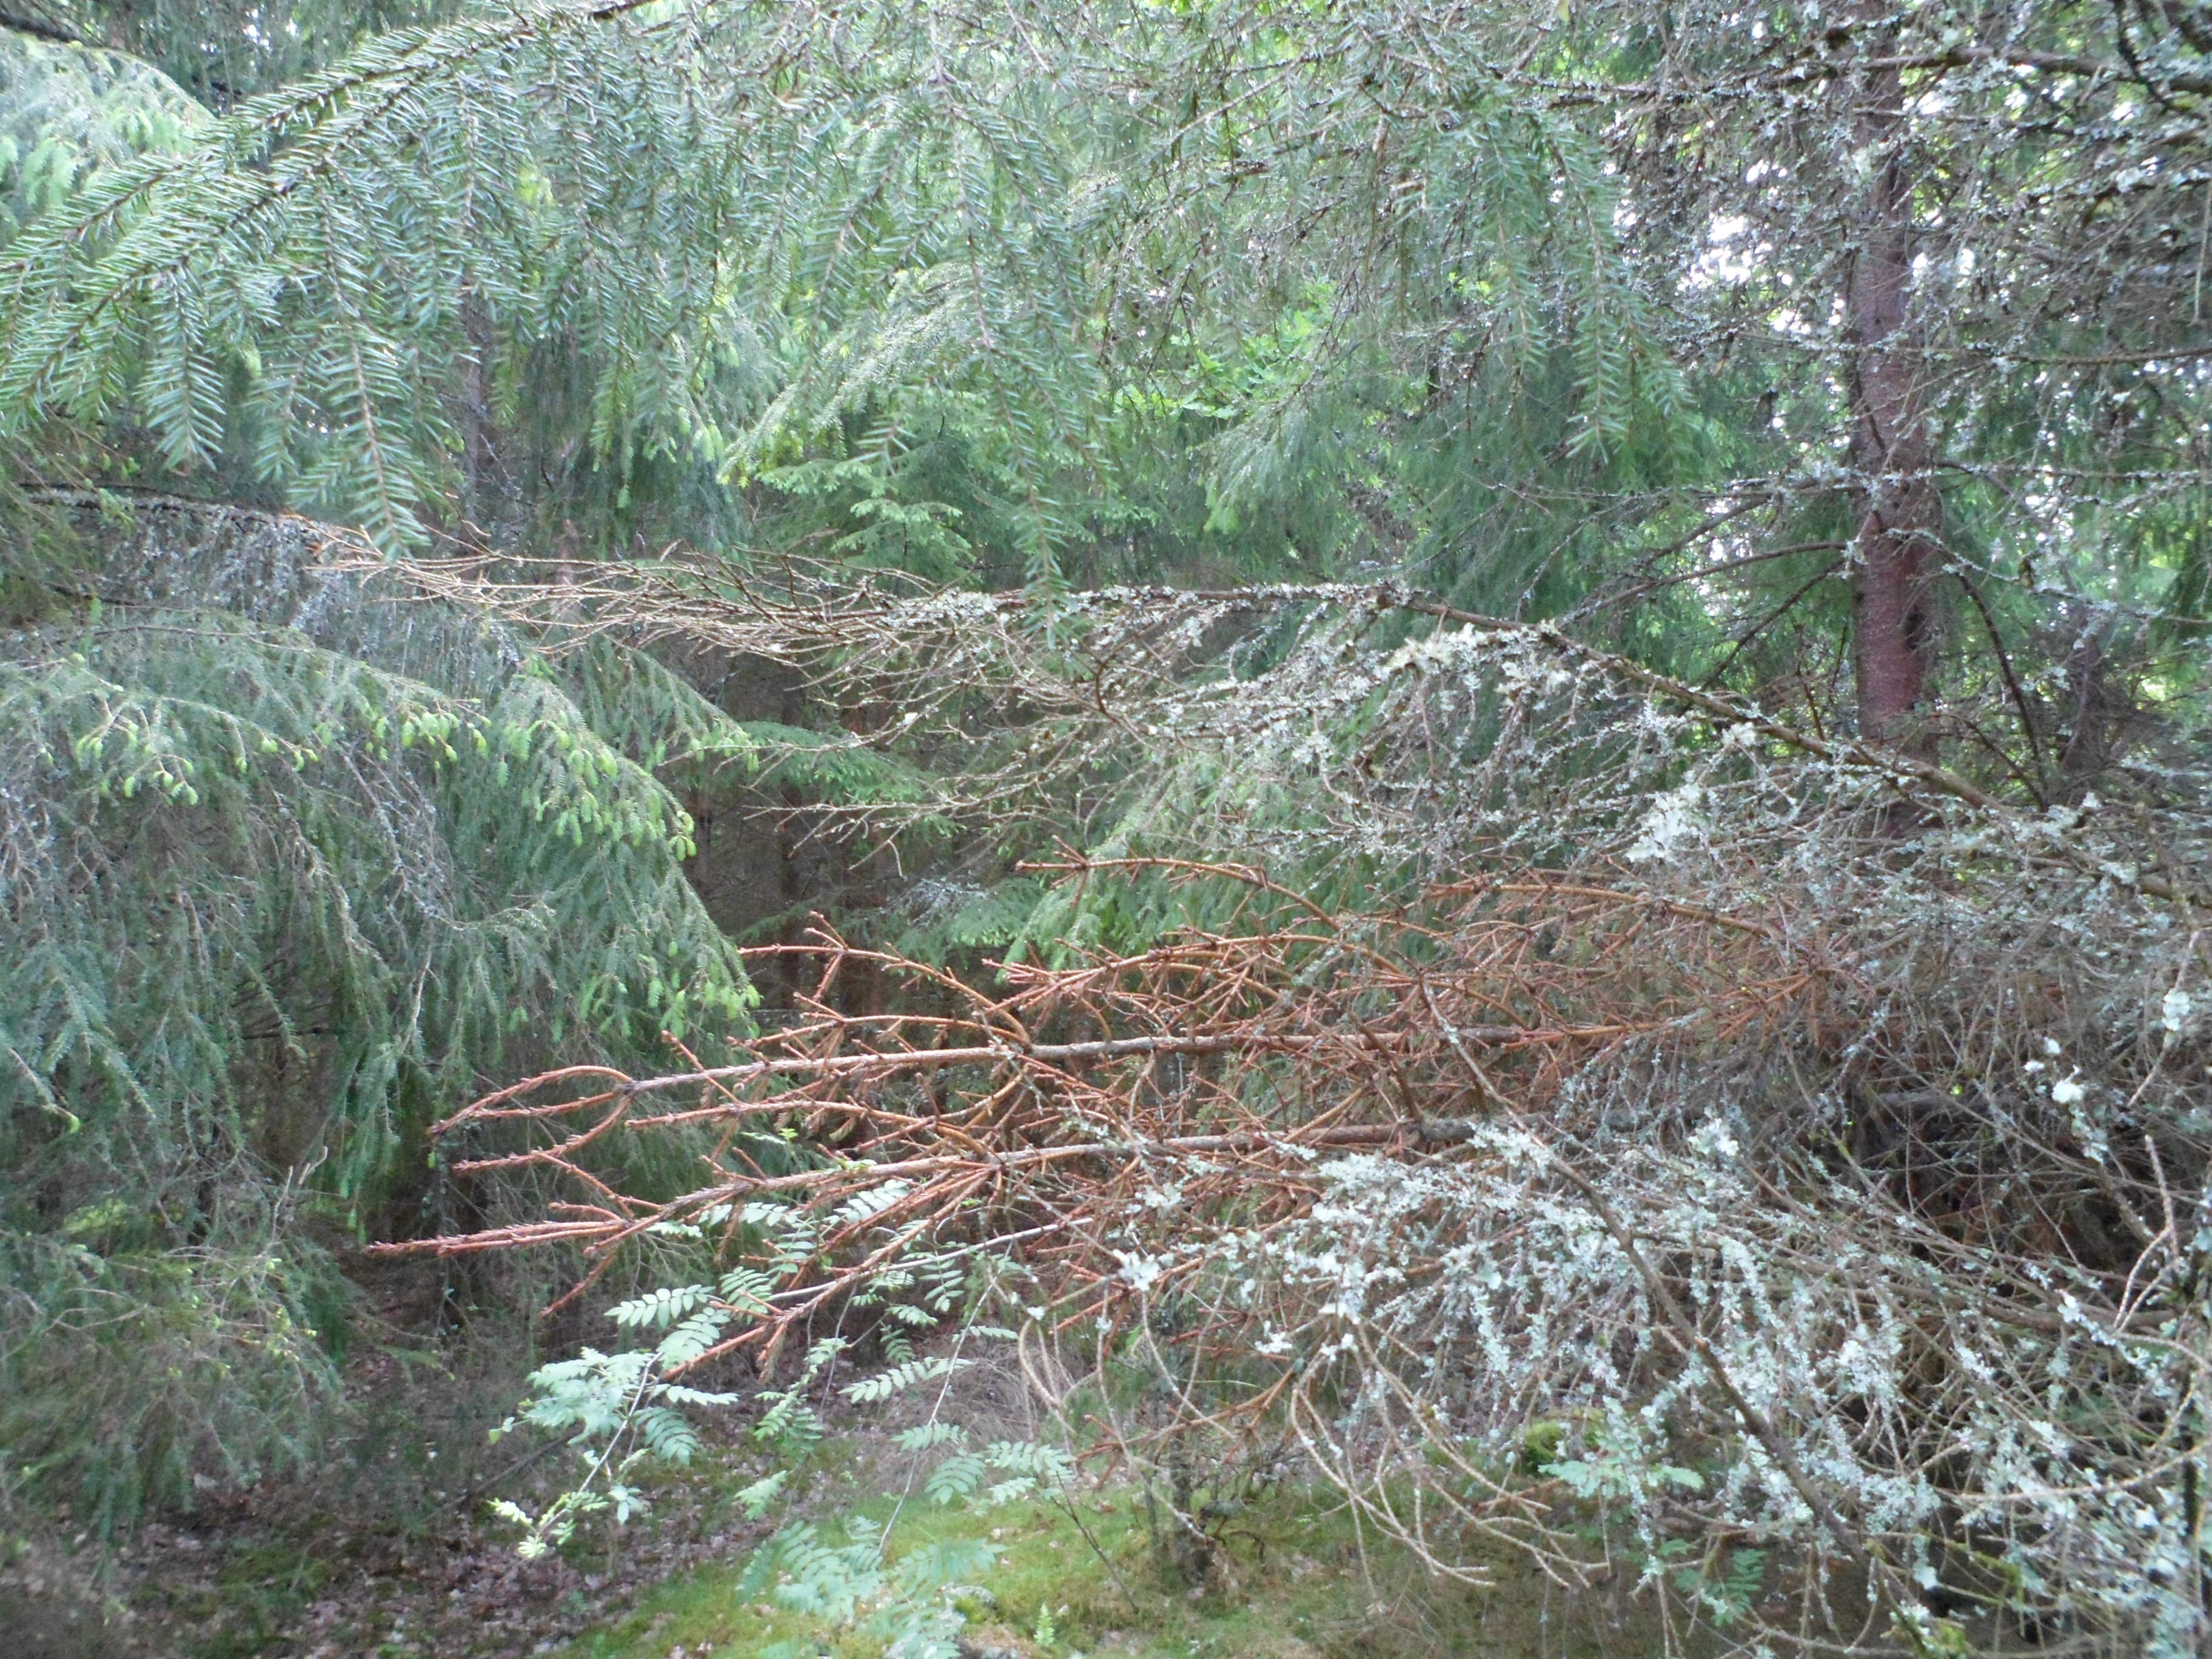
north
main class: Woodland
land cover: Spruce dominated coniferous woodland
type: boreal forest
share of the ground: 50 - 75 %
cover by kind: coniferous forest trees 50 %, lichens and mosses 25 %, broadleaved forest trees 10 %, shrubs 10 %, herbaceous plants 5 %
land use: Forestry
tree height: > 5 m
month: June
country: SE
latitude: 56.9423
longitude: 14.3525
